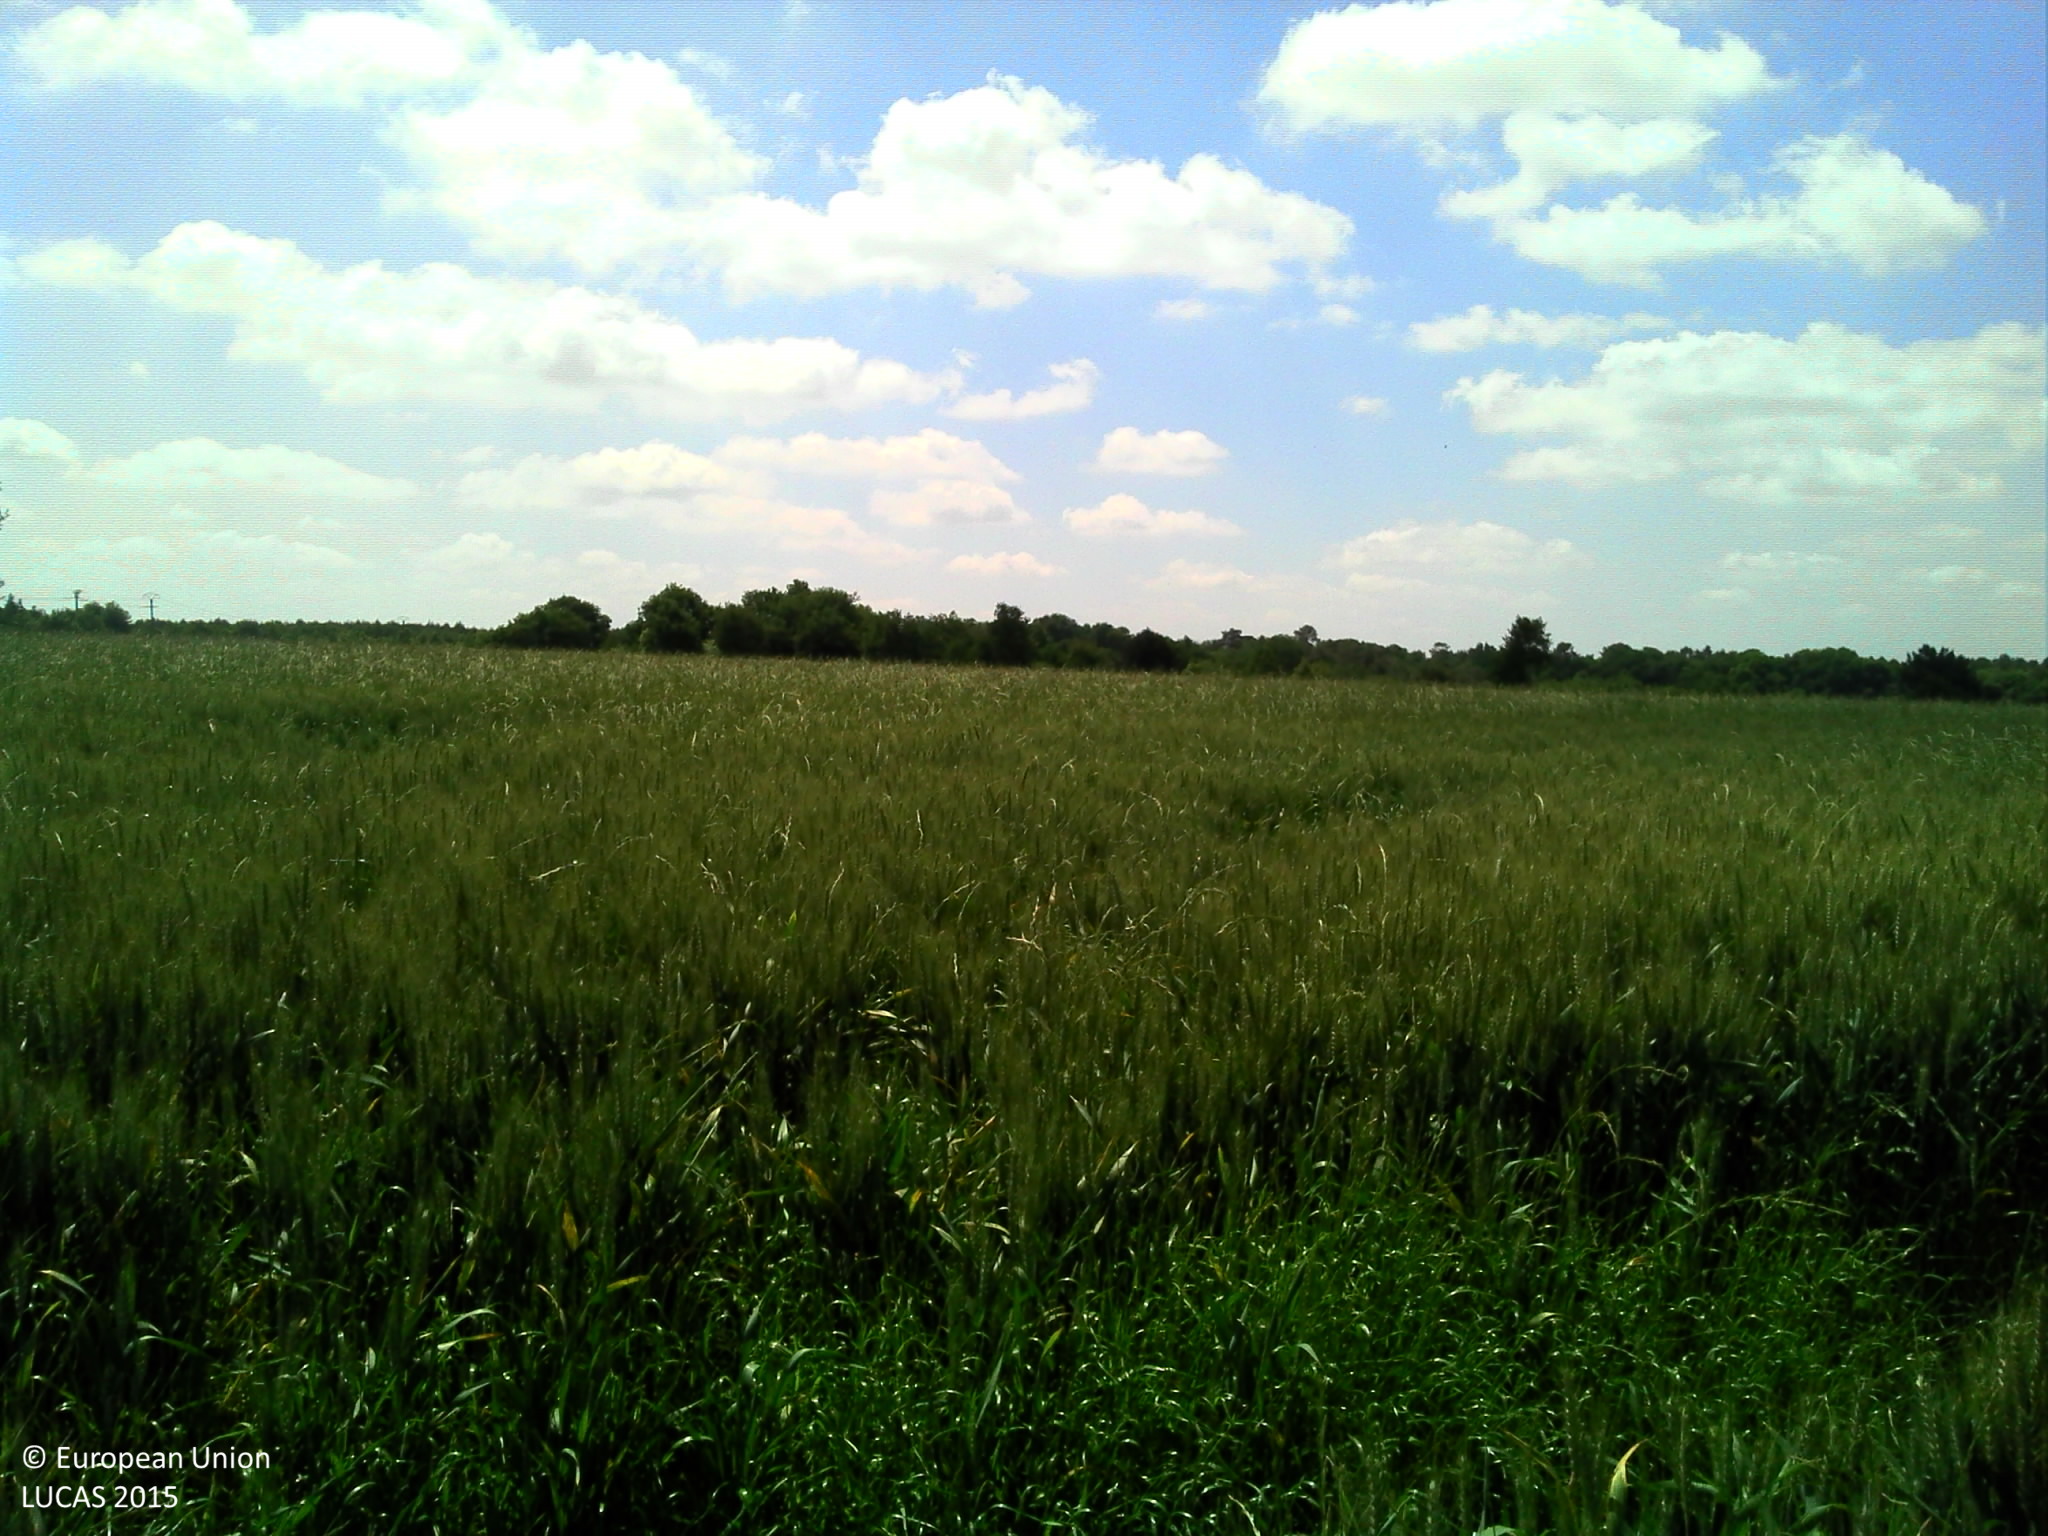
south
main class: Cropland
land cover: Common wheat
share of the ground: > 75 %
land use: Agriculture (excluding fallow land and kitchen gardens)
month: June
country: FR
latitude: 47.9964
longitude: -1.8840
